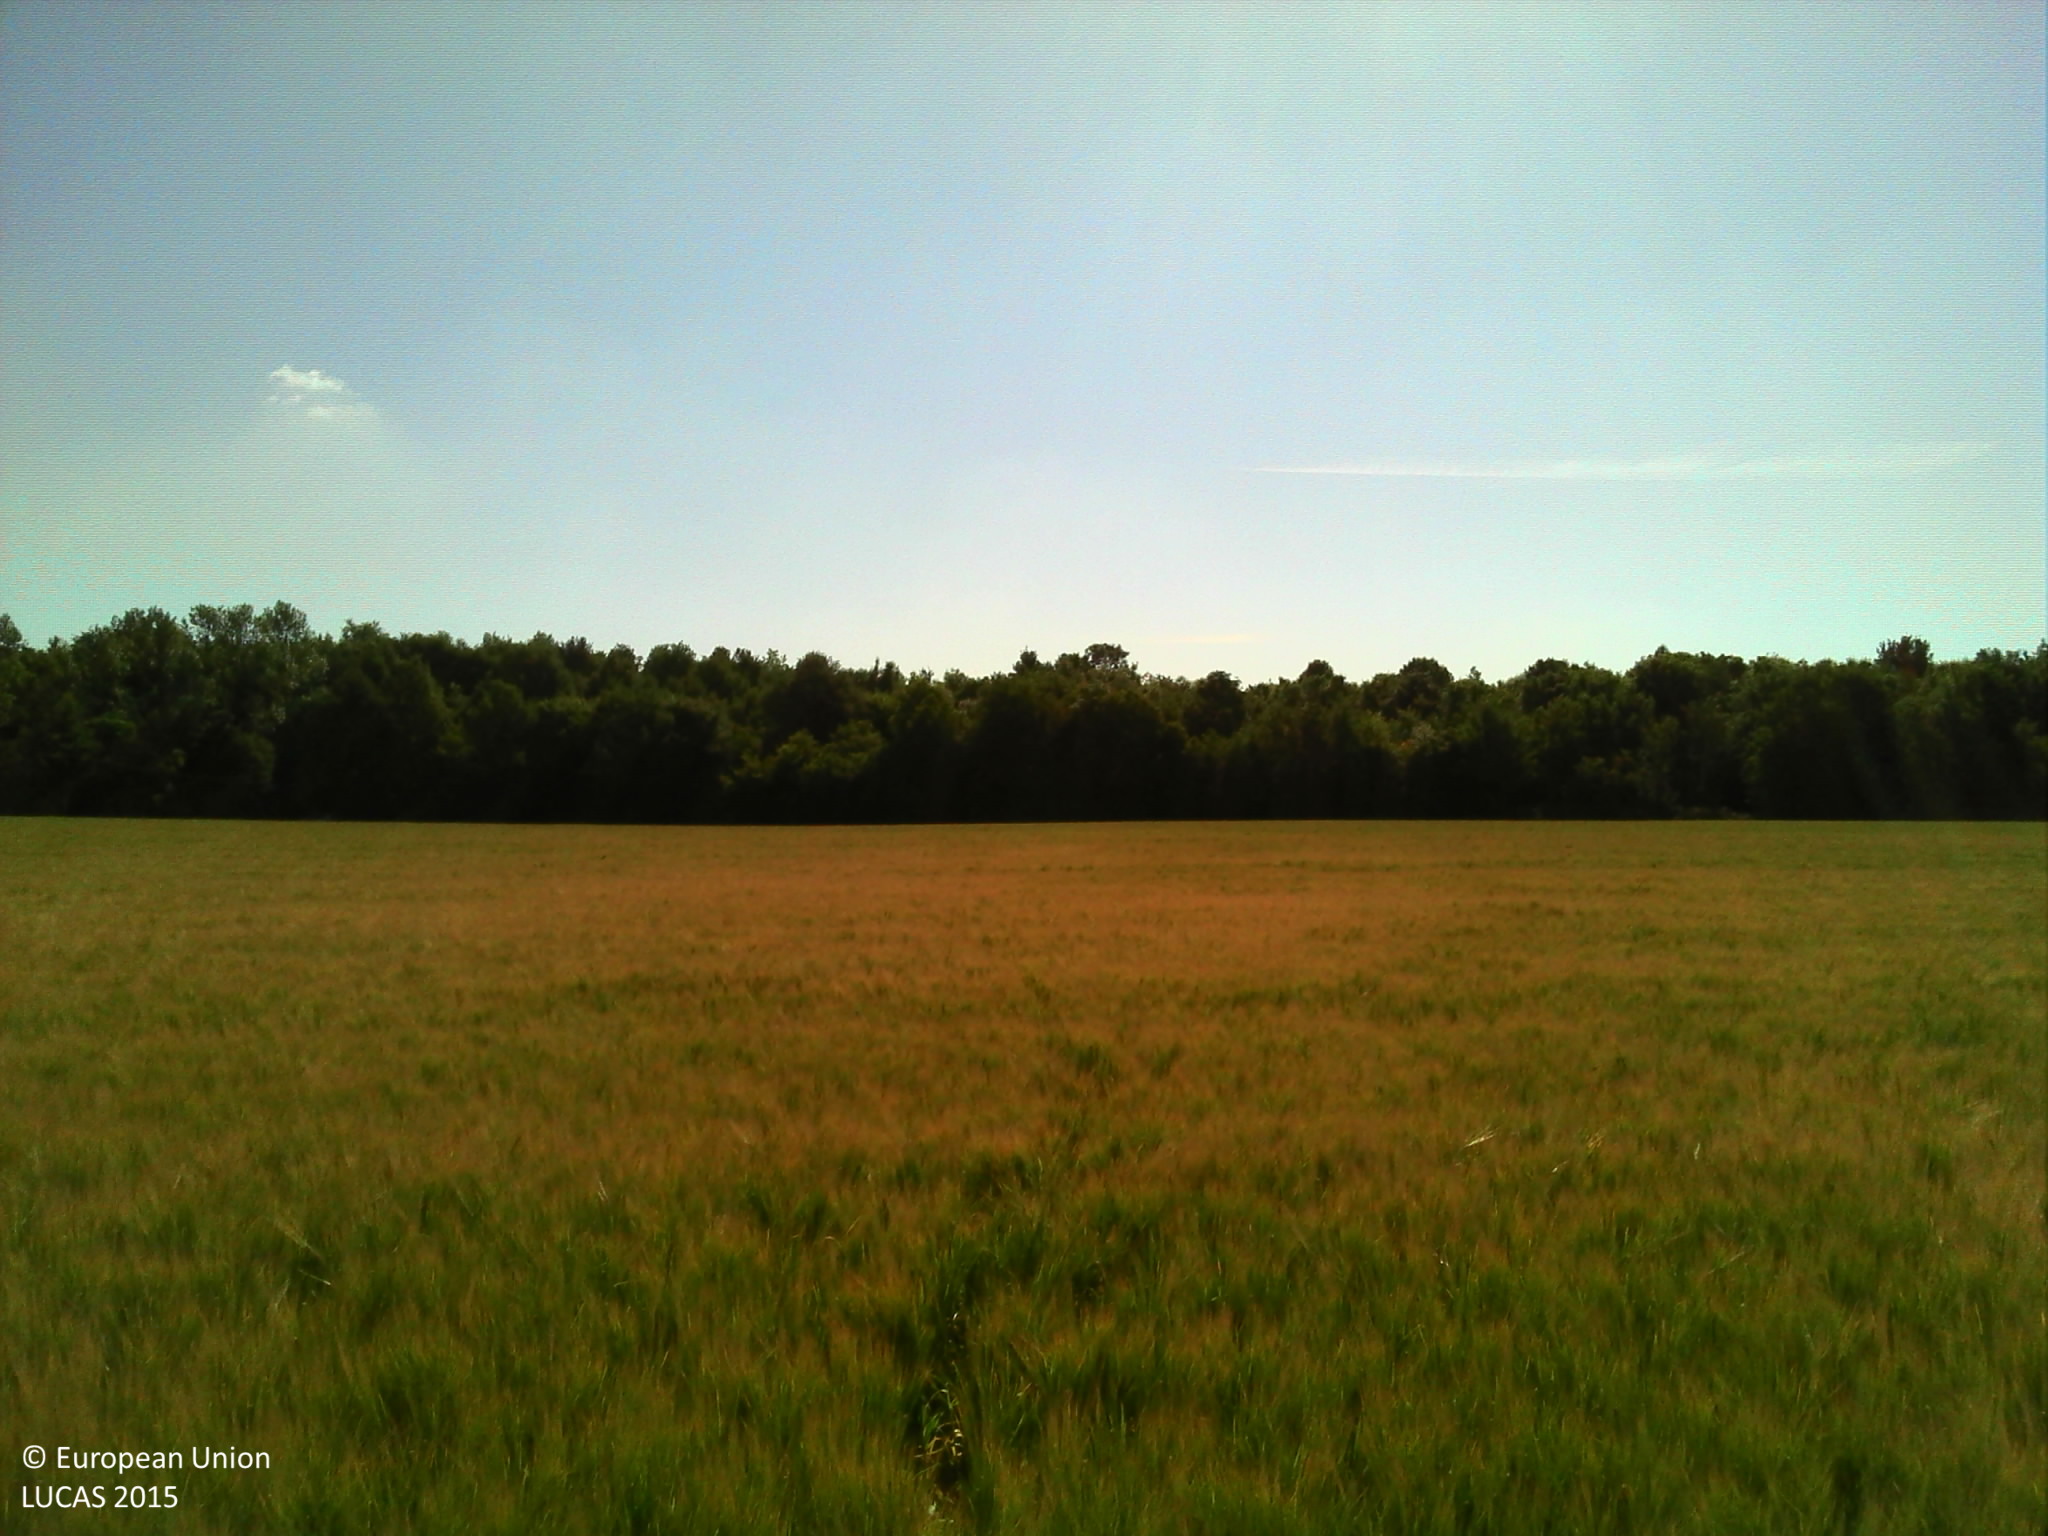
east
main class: Cropland
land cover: Barley
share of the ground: > 75 %
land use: Agriculture (excluding fallow land and kitchen gardens)
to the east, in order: Barley; Grass margins; Tracks; Groves; Broadleaved woodland
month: June
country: FR
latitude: 49.2238
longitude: 2.9192
